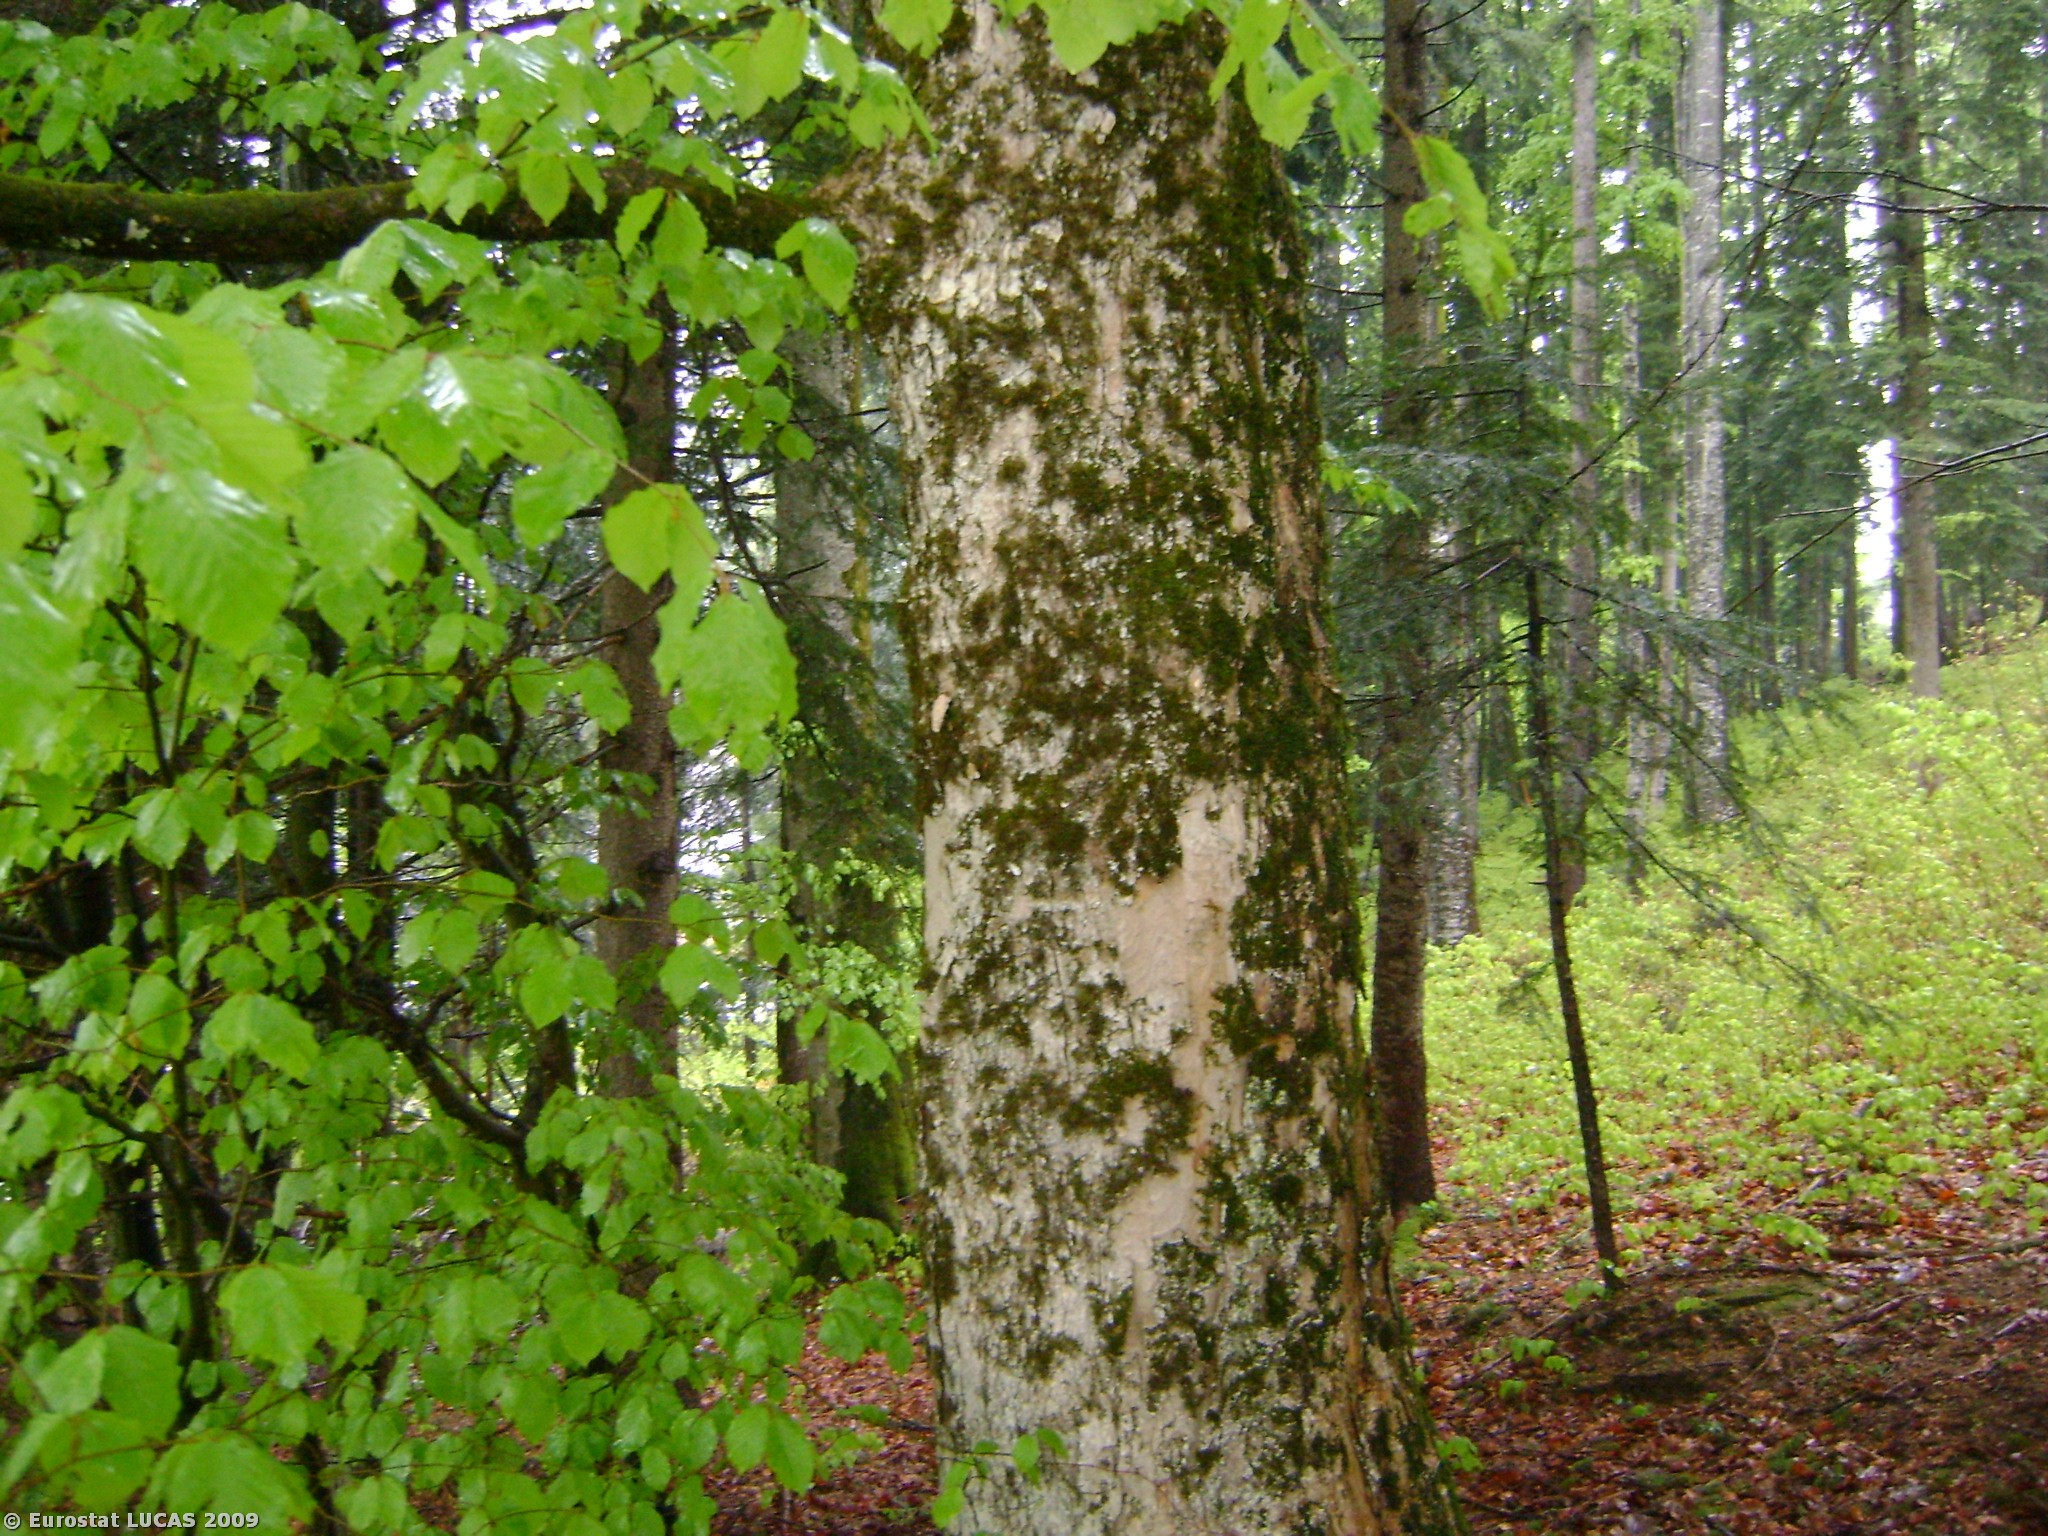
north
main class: Woodland
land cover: Mixed woodland
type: hemiboreal forest and nemoral coniferous forest and mixed broadleaved-coniferous forest
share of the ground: > 75 %
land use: Forestry
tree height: > 5 m
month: May
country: AT
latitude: 47.7797
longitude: 13.2417
